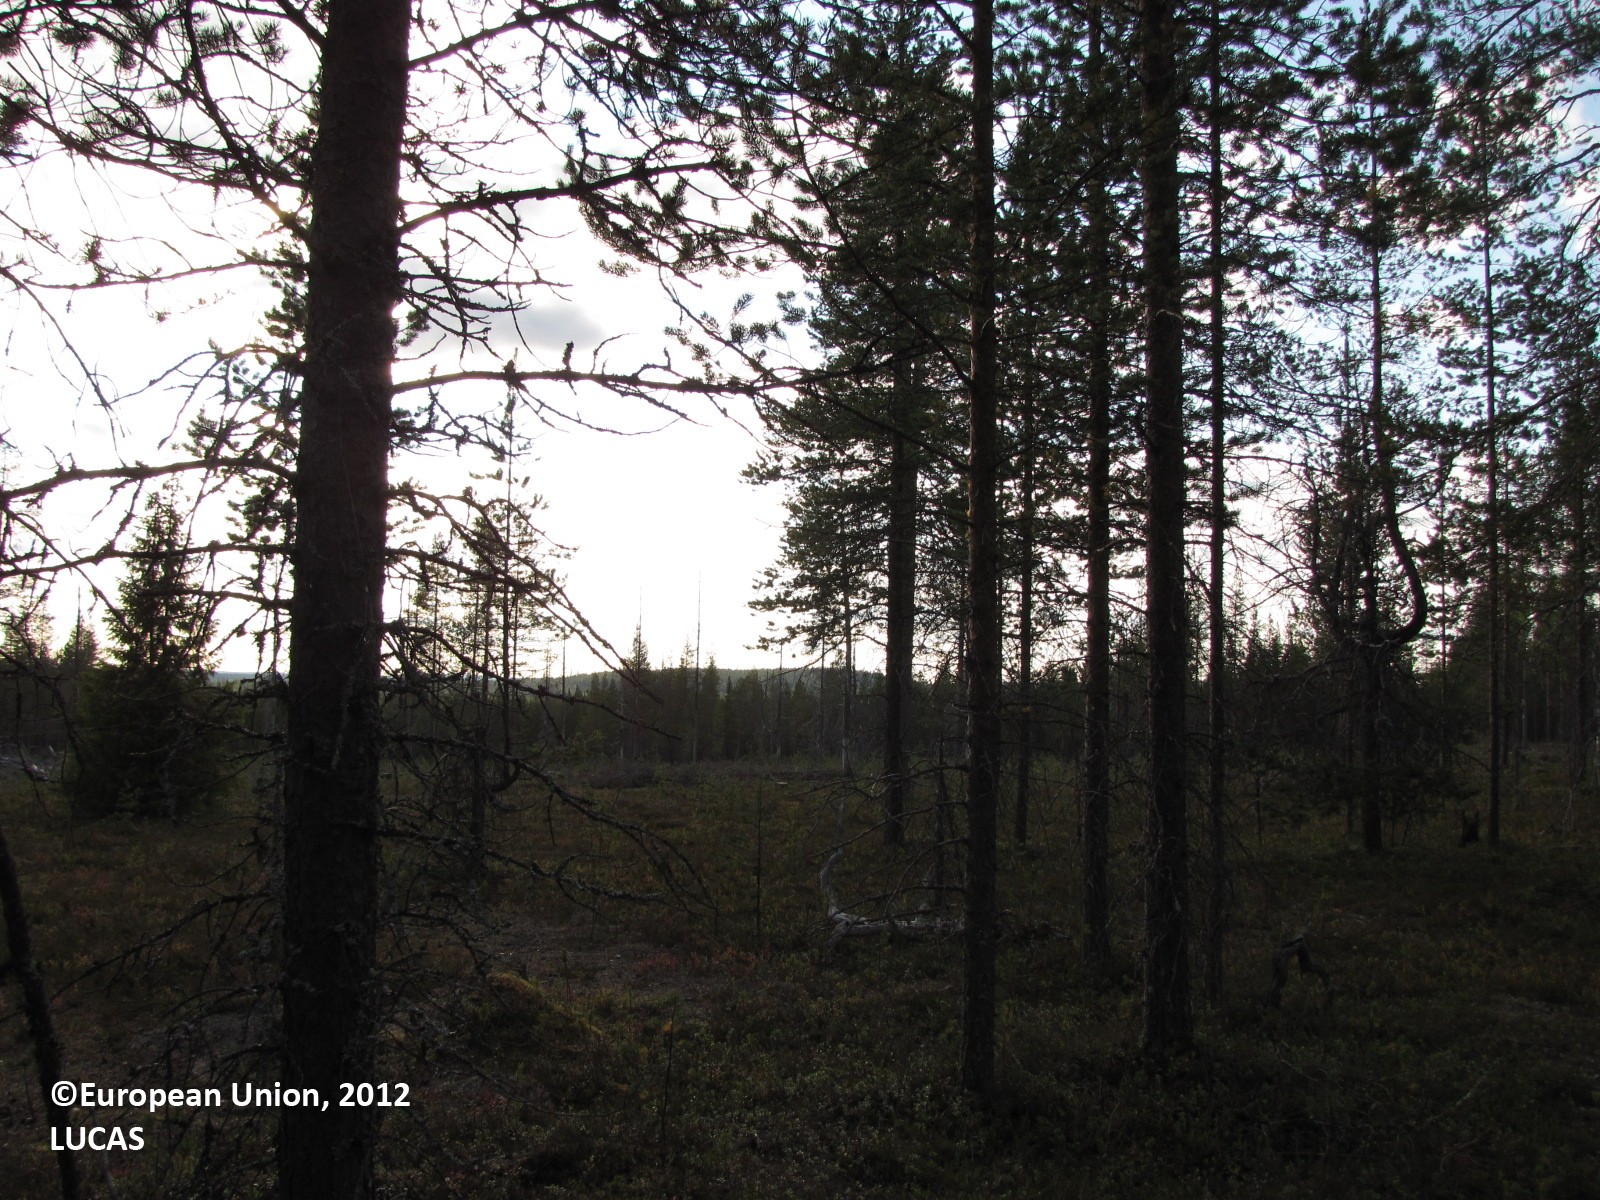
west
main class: Woodland
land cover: Pine dominated coniferous woodland
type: boreal forest
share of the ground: 25 - 50 %
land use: Forestry
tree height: > 5 m
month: August
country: FI
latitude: 67.0228
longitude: 25.0375
